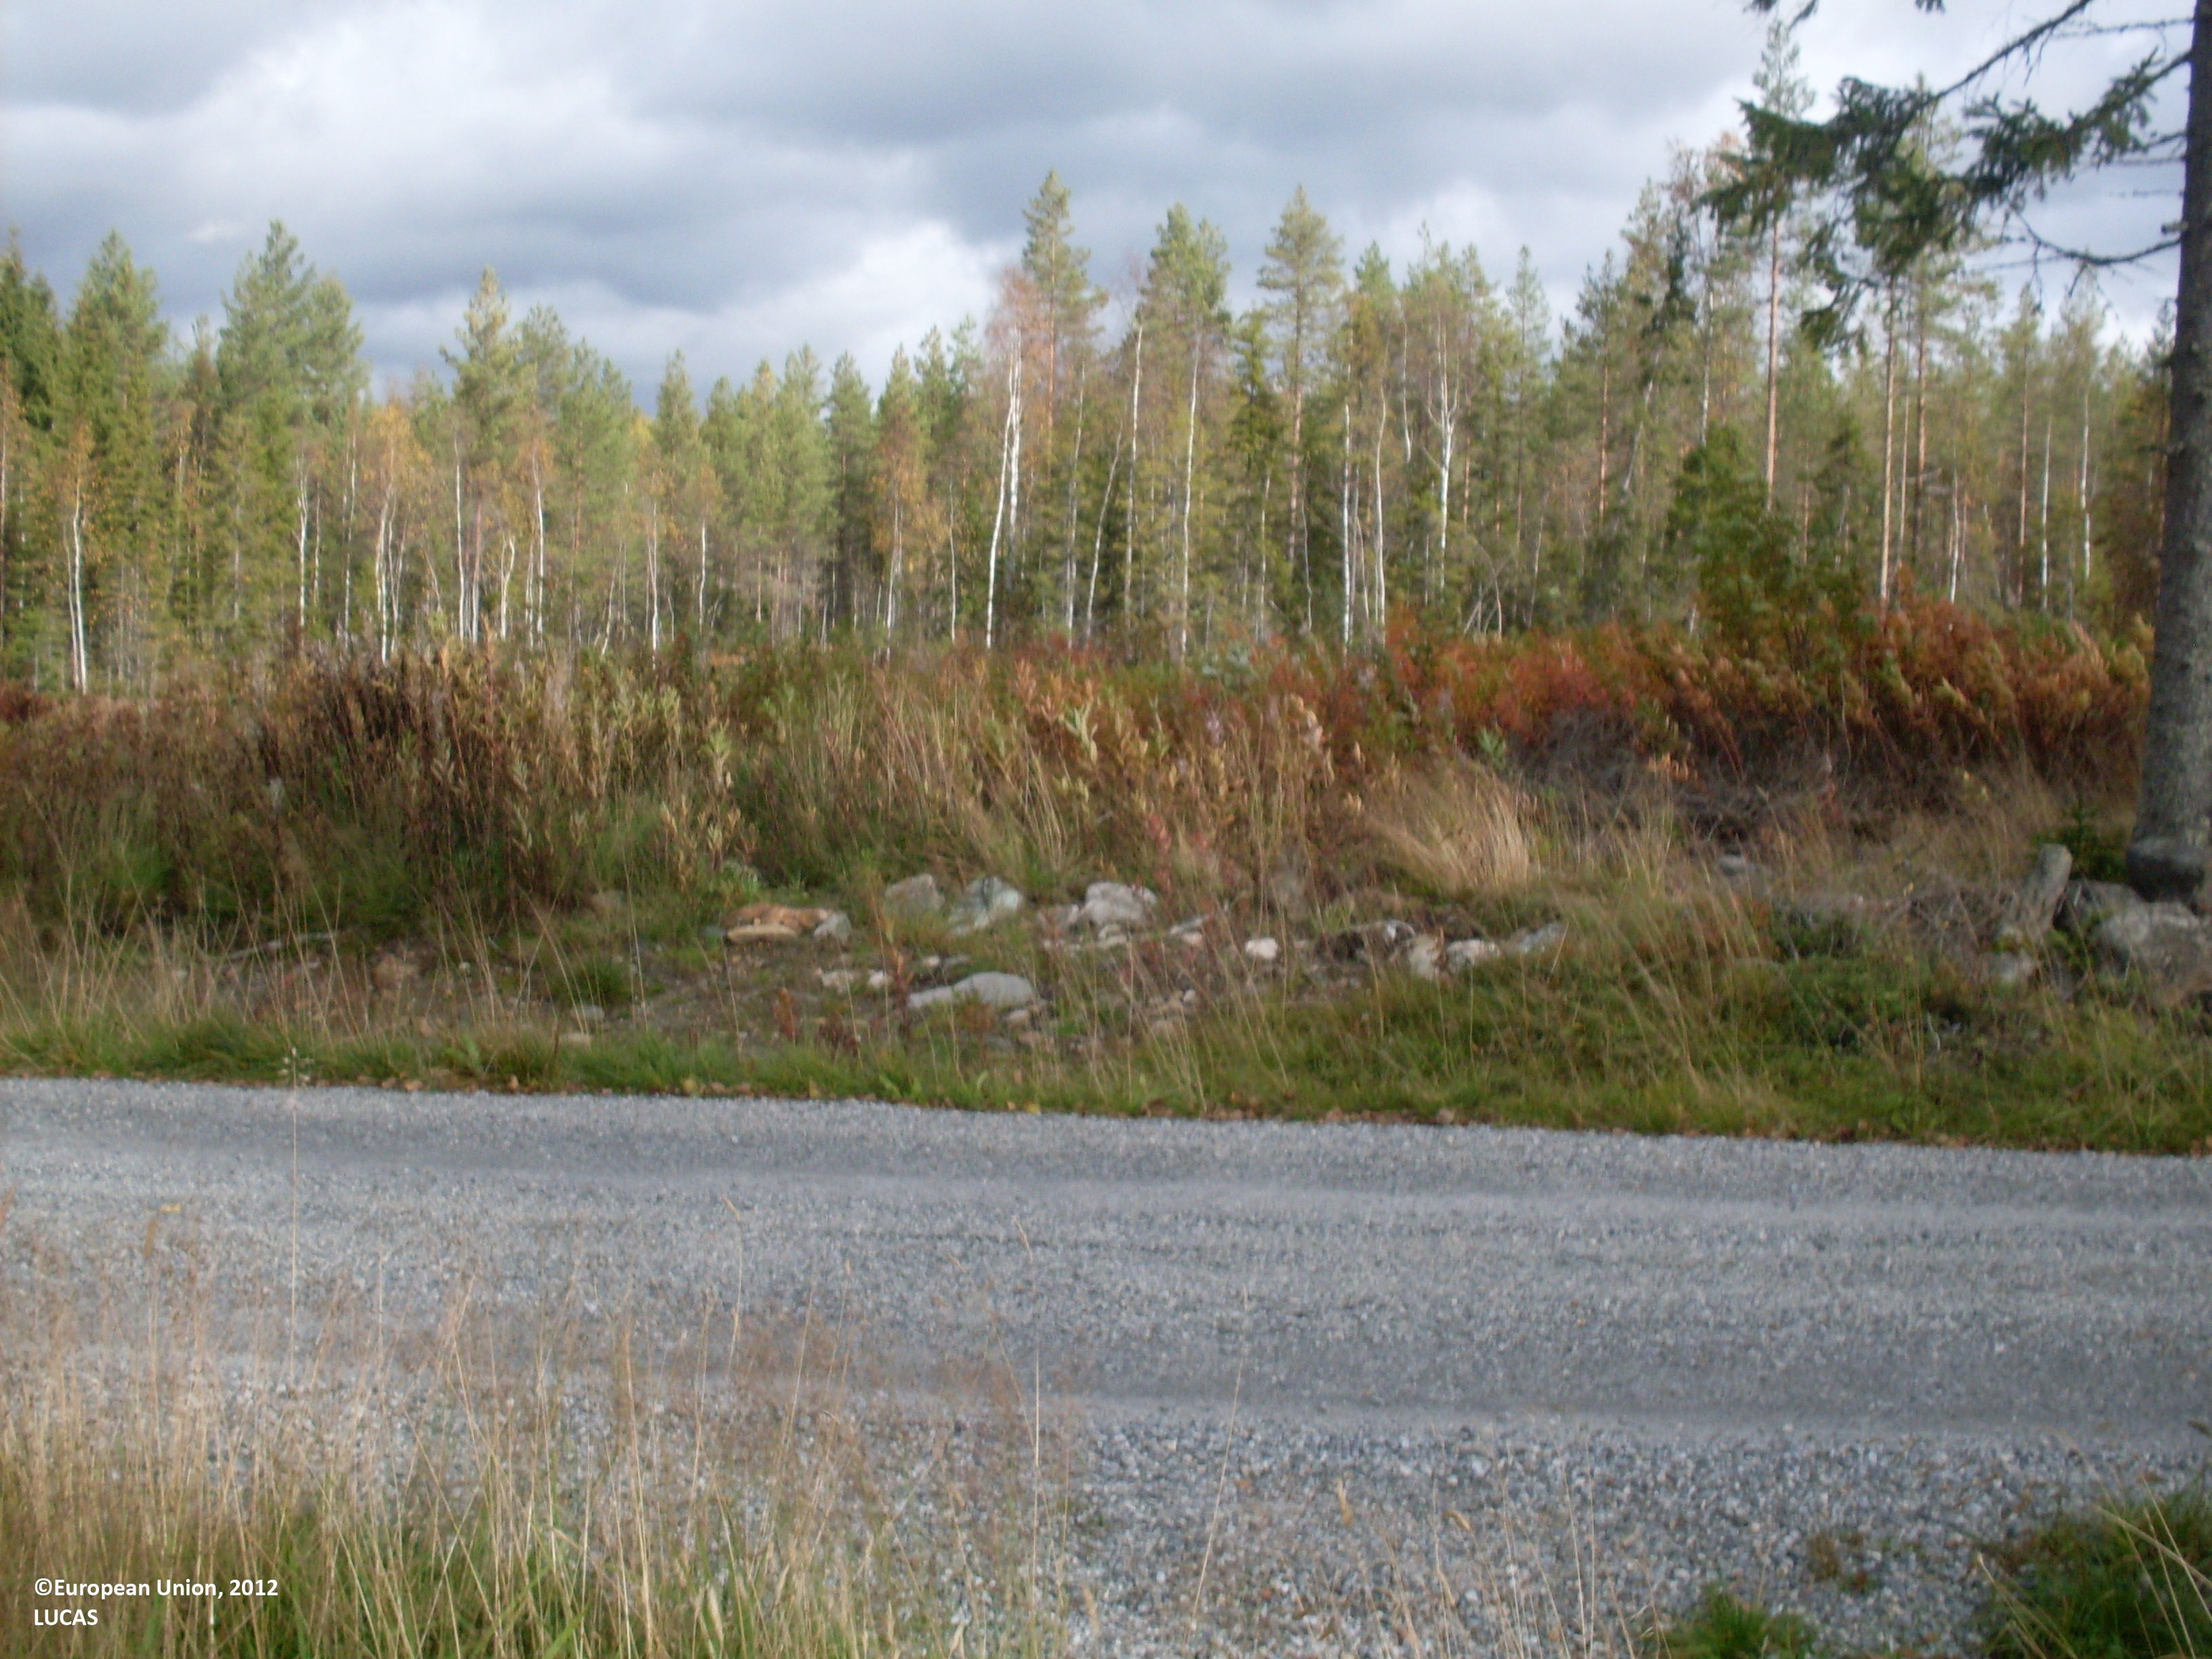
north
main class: Grassland
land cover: Grassland without tree/shrub cover
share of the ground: > 75 %
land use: Agriculture (excluding fallow land and kitchen gardens)
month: September
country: FI
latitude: 64.2554
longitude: 28.2676
